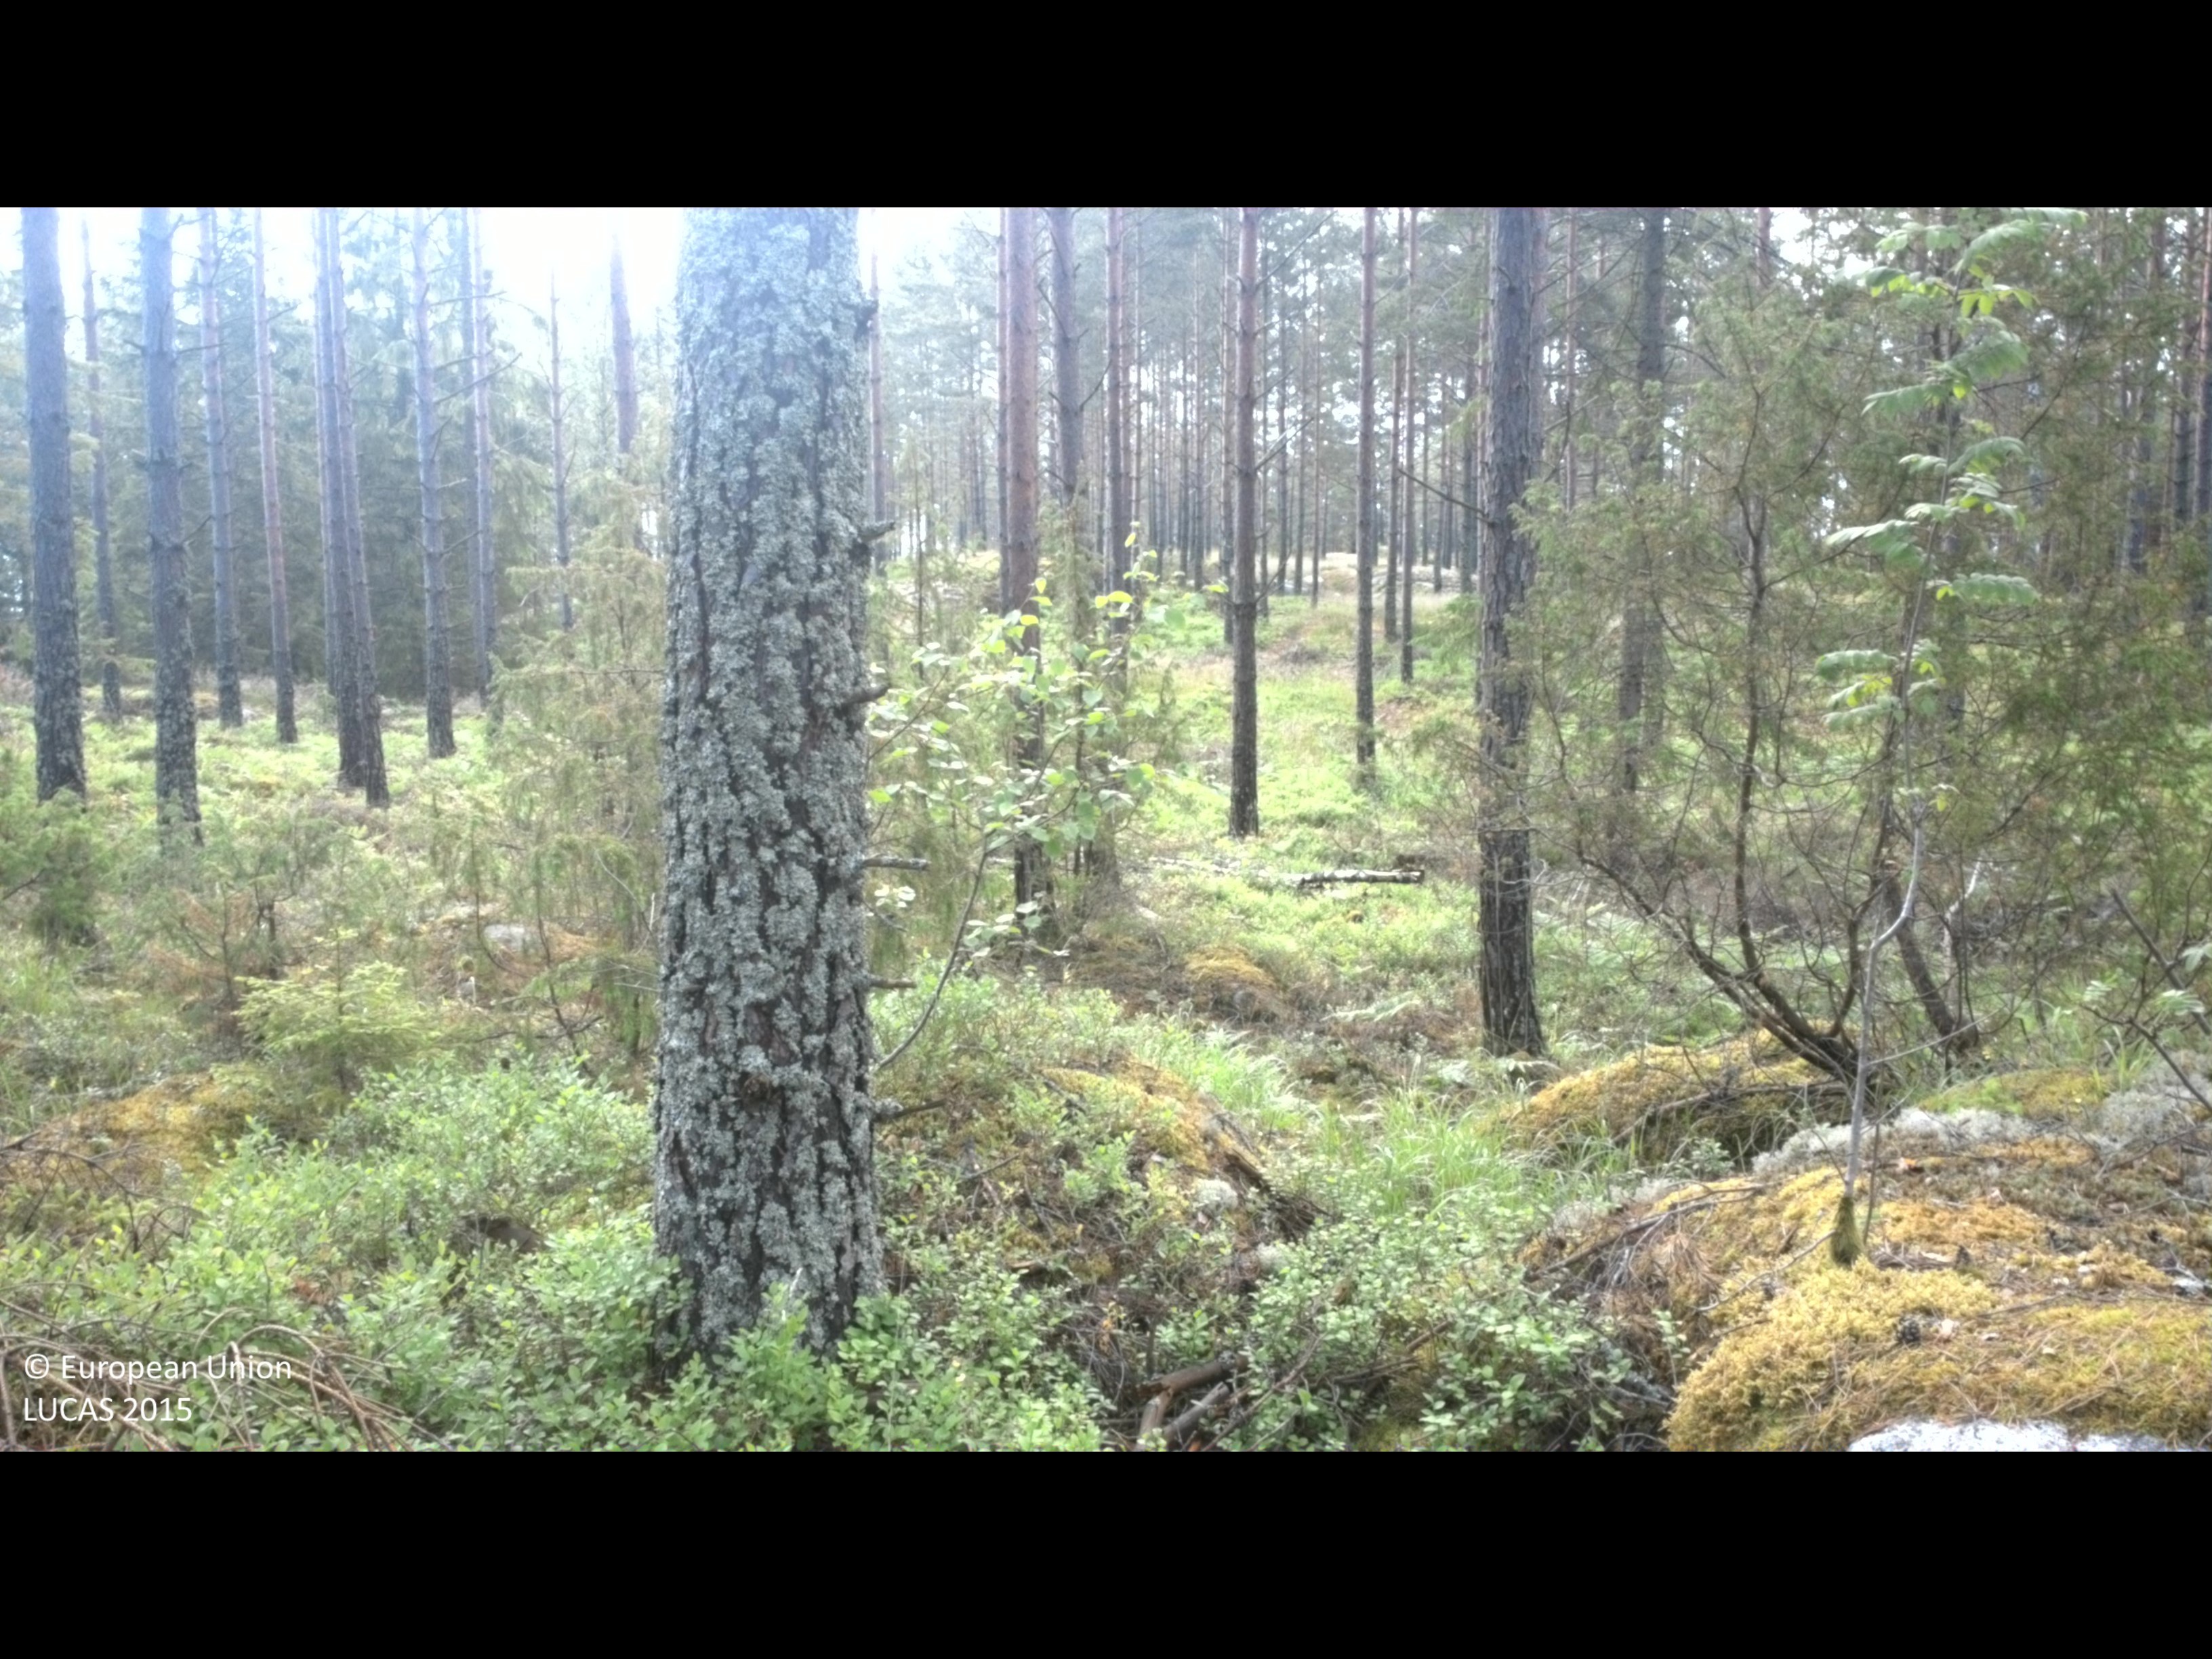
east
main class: Woodland
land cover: Pine dominated coniferous woodland
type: boreal forest
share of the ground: 50 - 75 %
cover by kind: coniferous forest trees 60 %, shrubs 25 %, broadleaved forest trees 10 %, lichens and mosses 5 %
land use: Forestry
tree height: > 5 m
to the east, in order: Pine dominated coniferous woodland; Lichens and moss; Pine dominated coniferous woodland
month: June
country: SE
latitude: 57.8513
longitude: 16.3838
